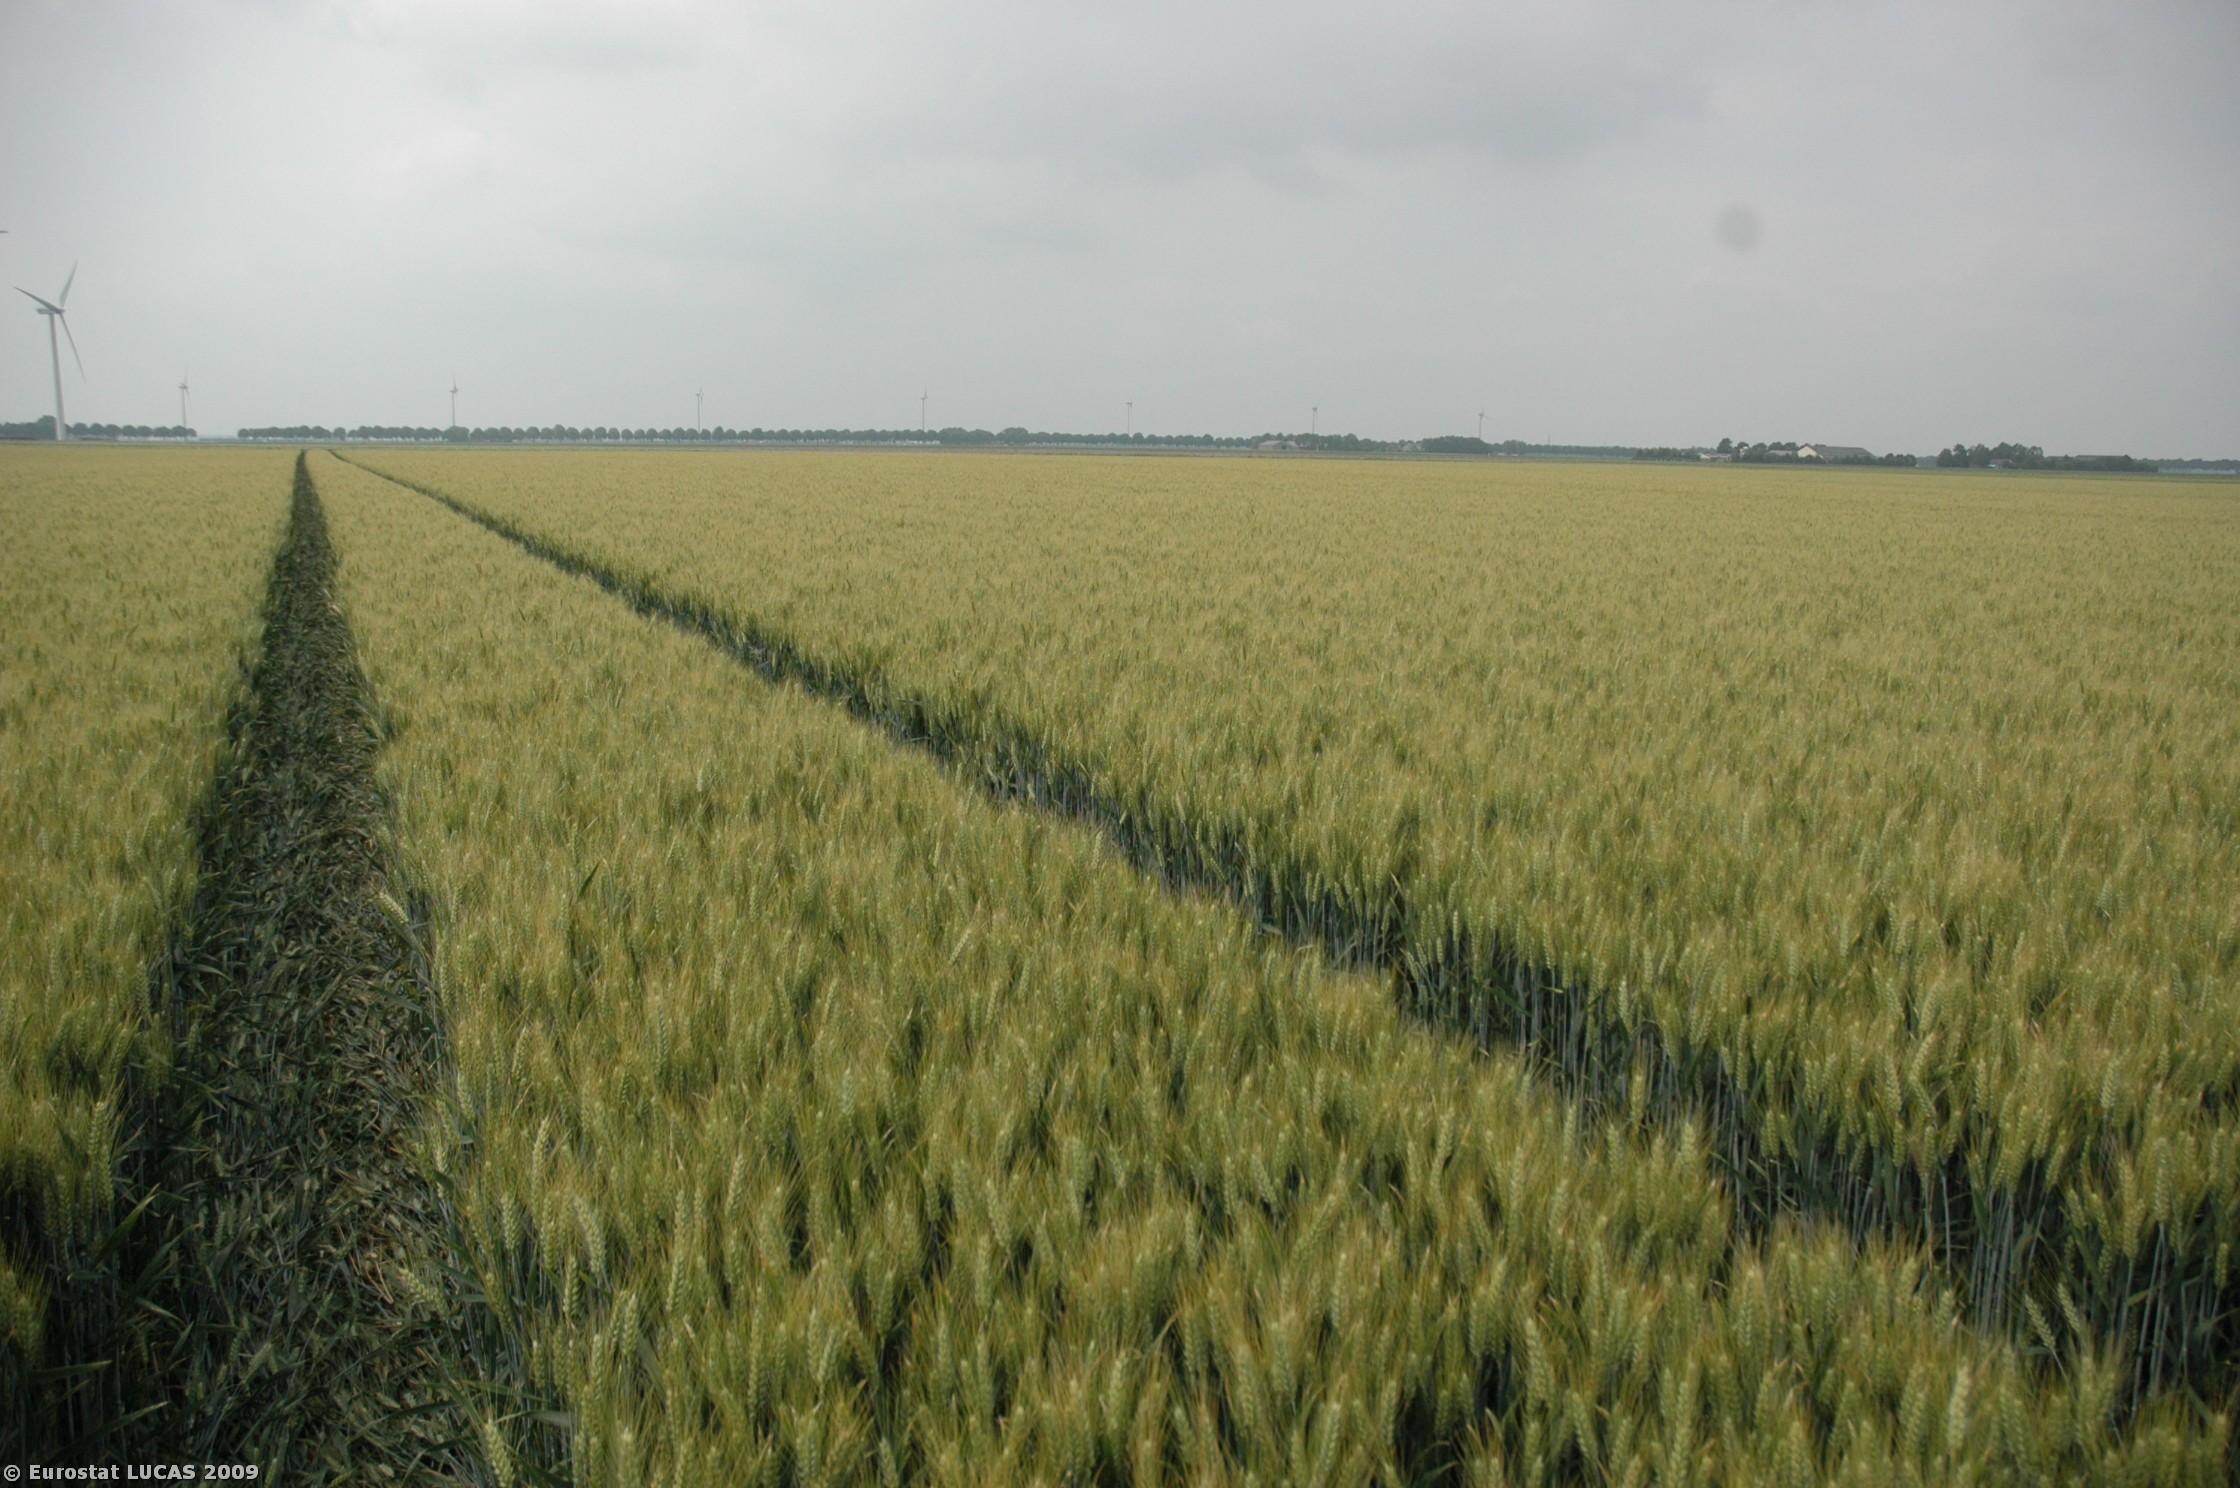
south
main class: Cropland
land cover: Common wheat
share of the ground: > 75 %
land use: Agriculture (excluding fallow land and kitchen gardens)
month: June
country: NL
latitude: 52.4601
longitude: 5.6570
